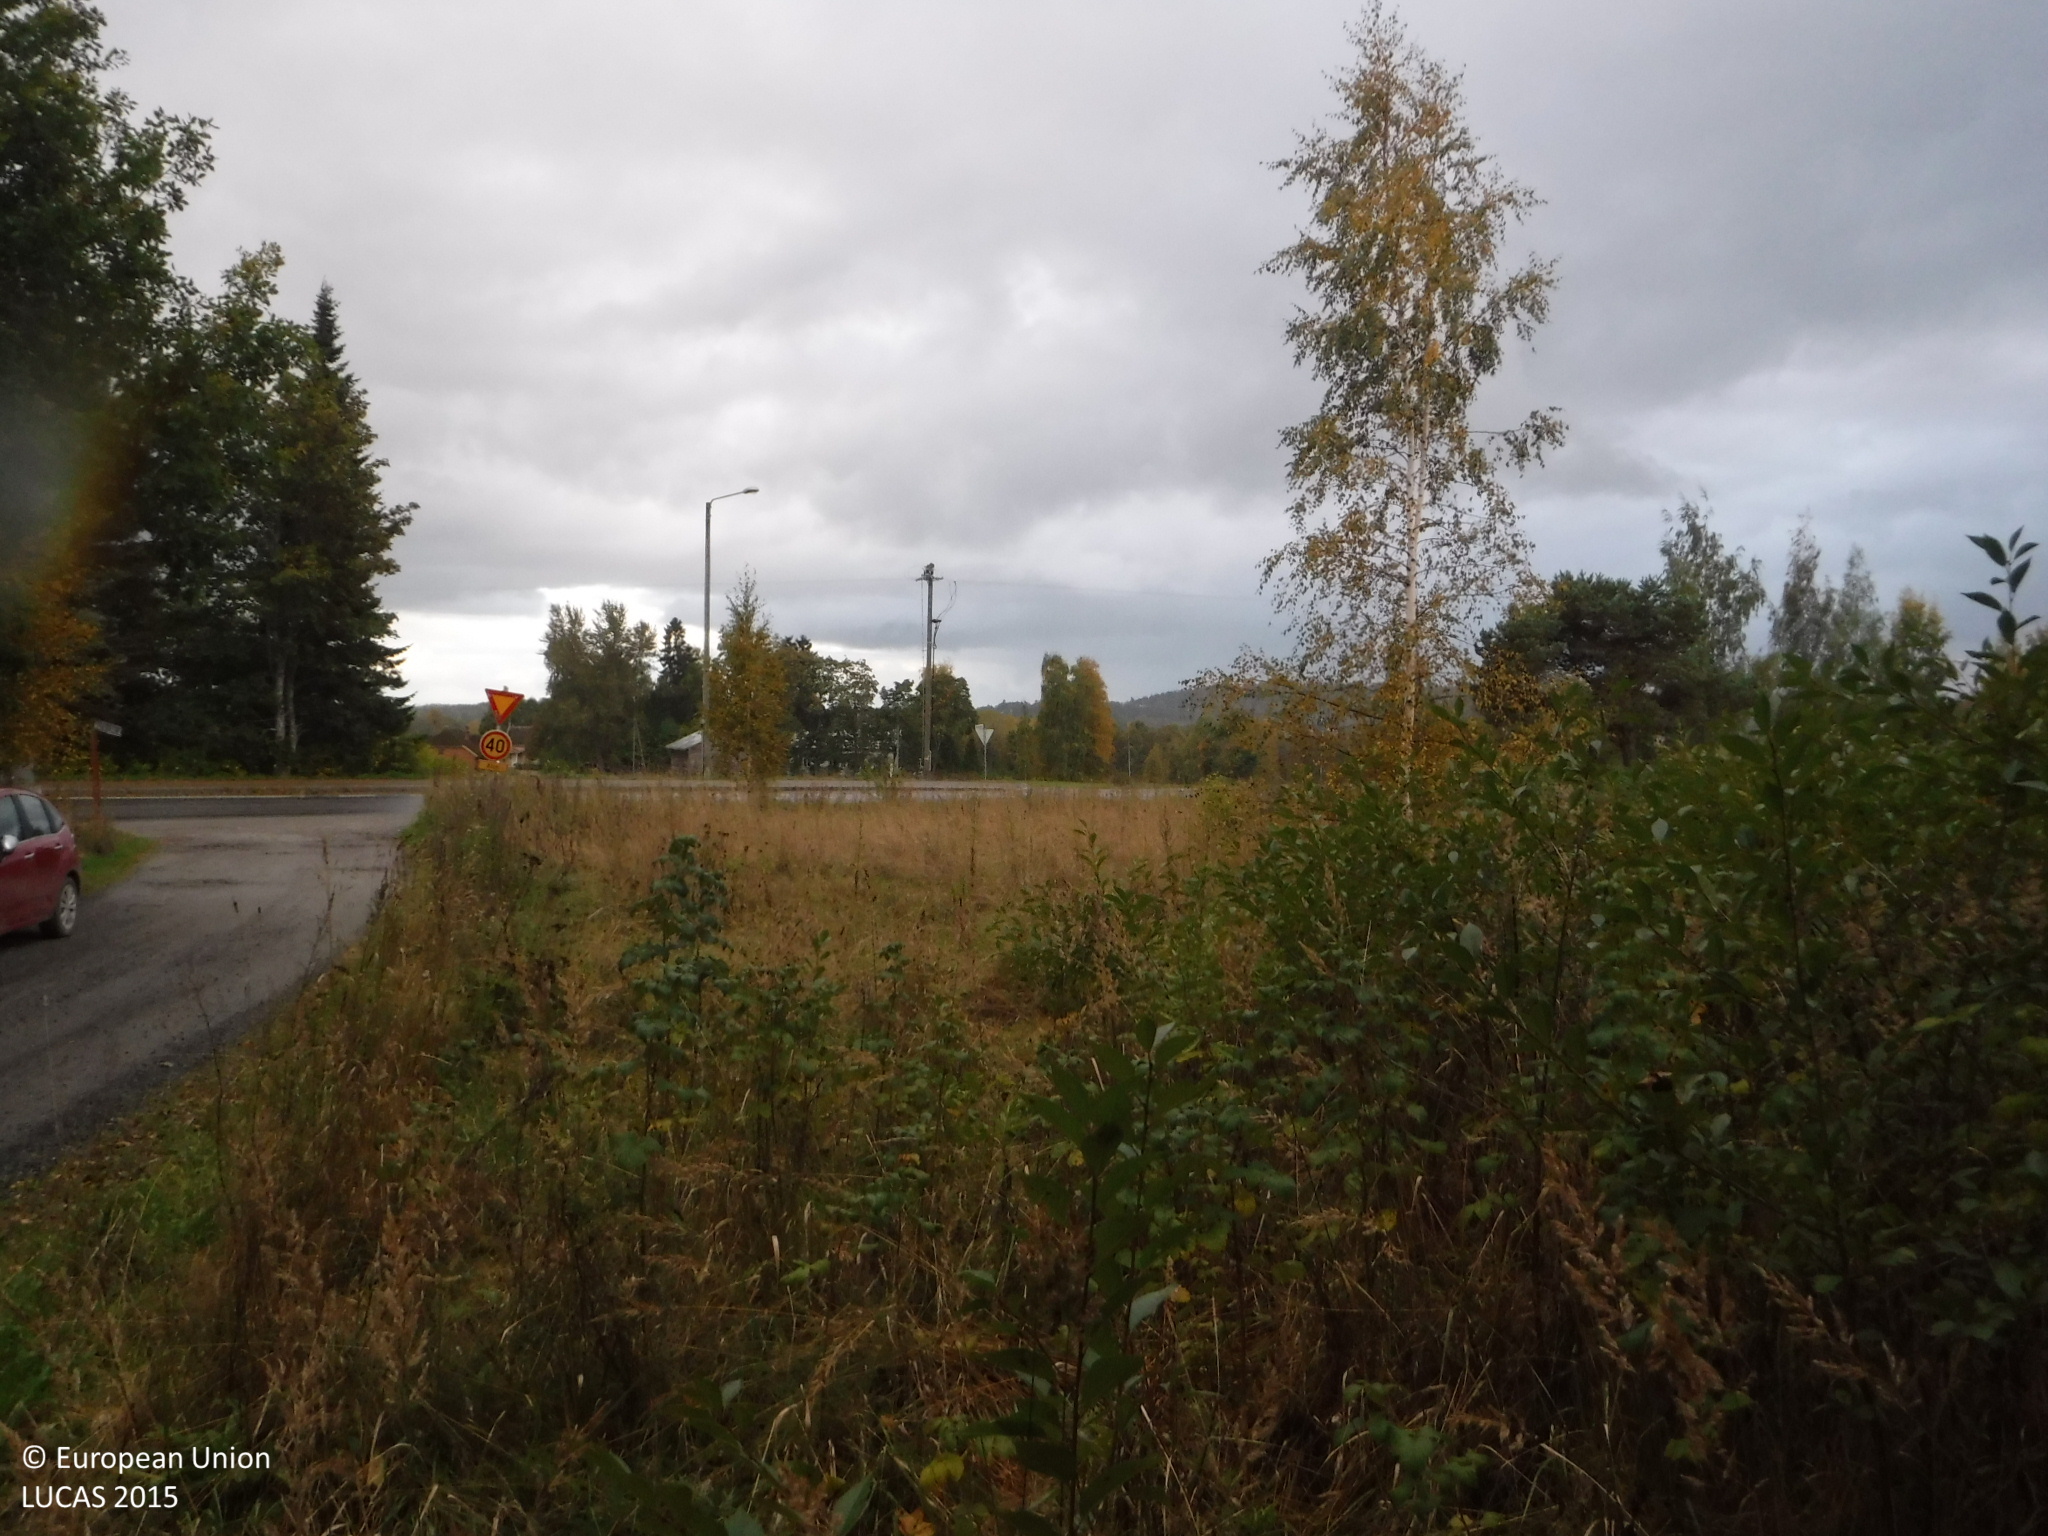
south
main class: Woodland
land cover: Broadleaved woodland
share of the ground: > 75 %
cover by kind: broadleaved forest trees 80 %, herbaceous plants 20 %
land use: Semi-natural and natural areas not in use
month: September
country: FI
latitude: 61.4871
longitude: 24.0805
